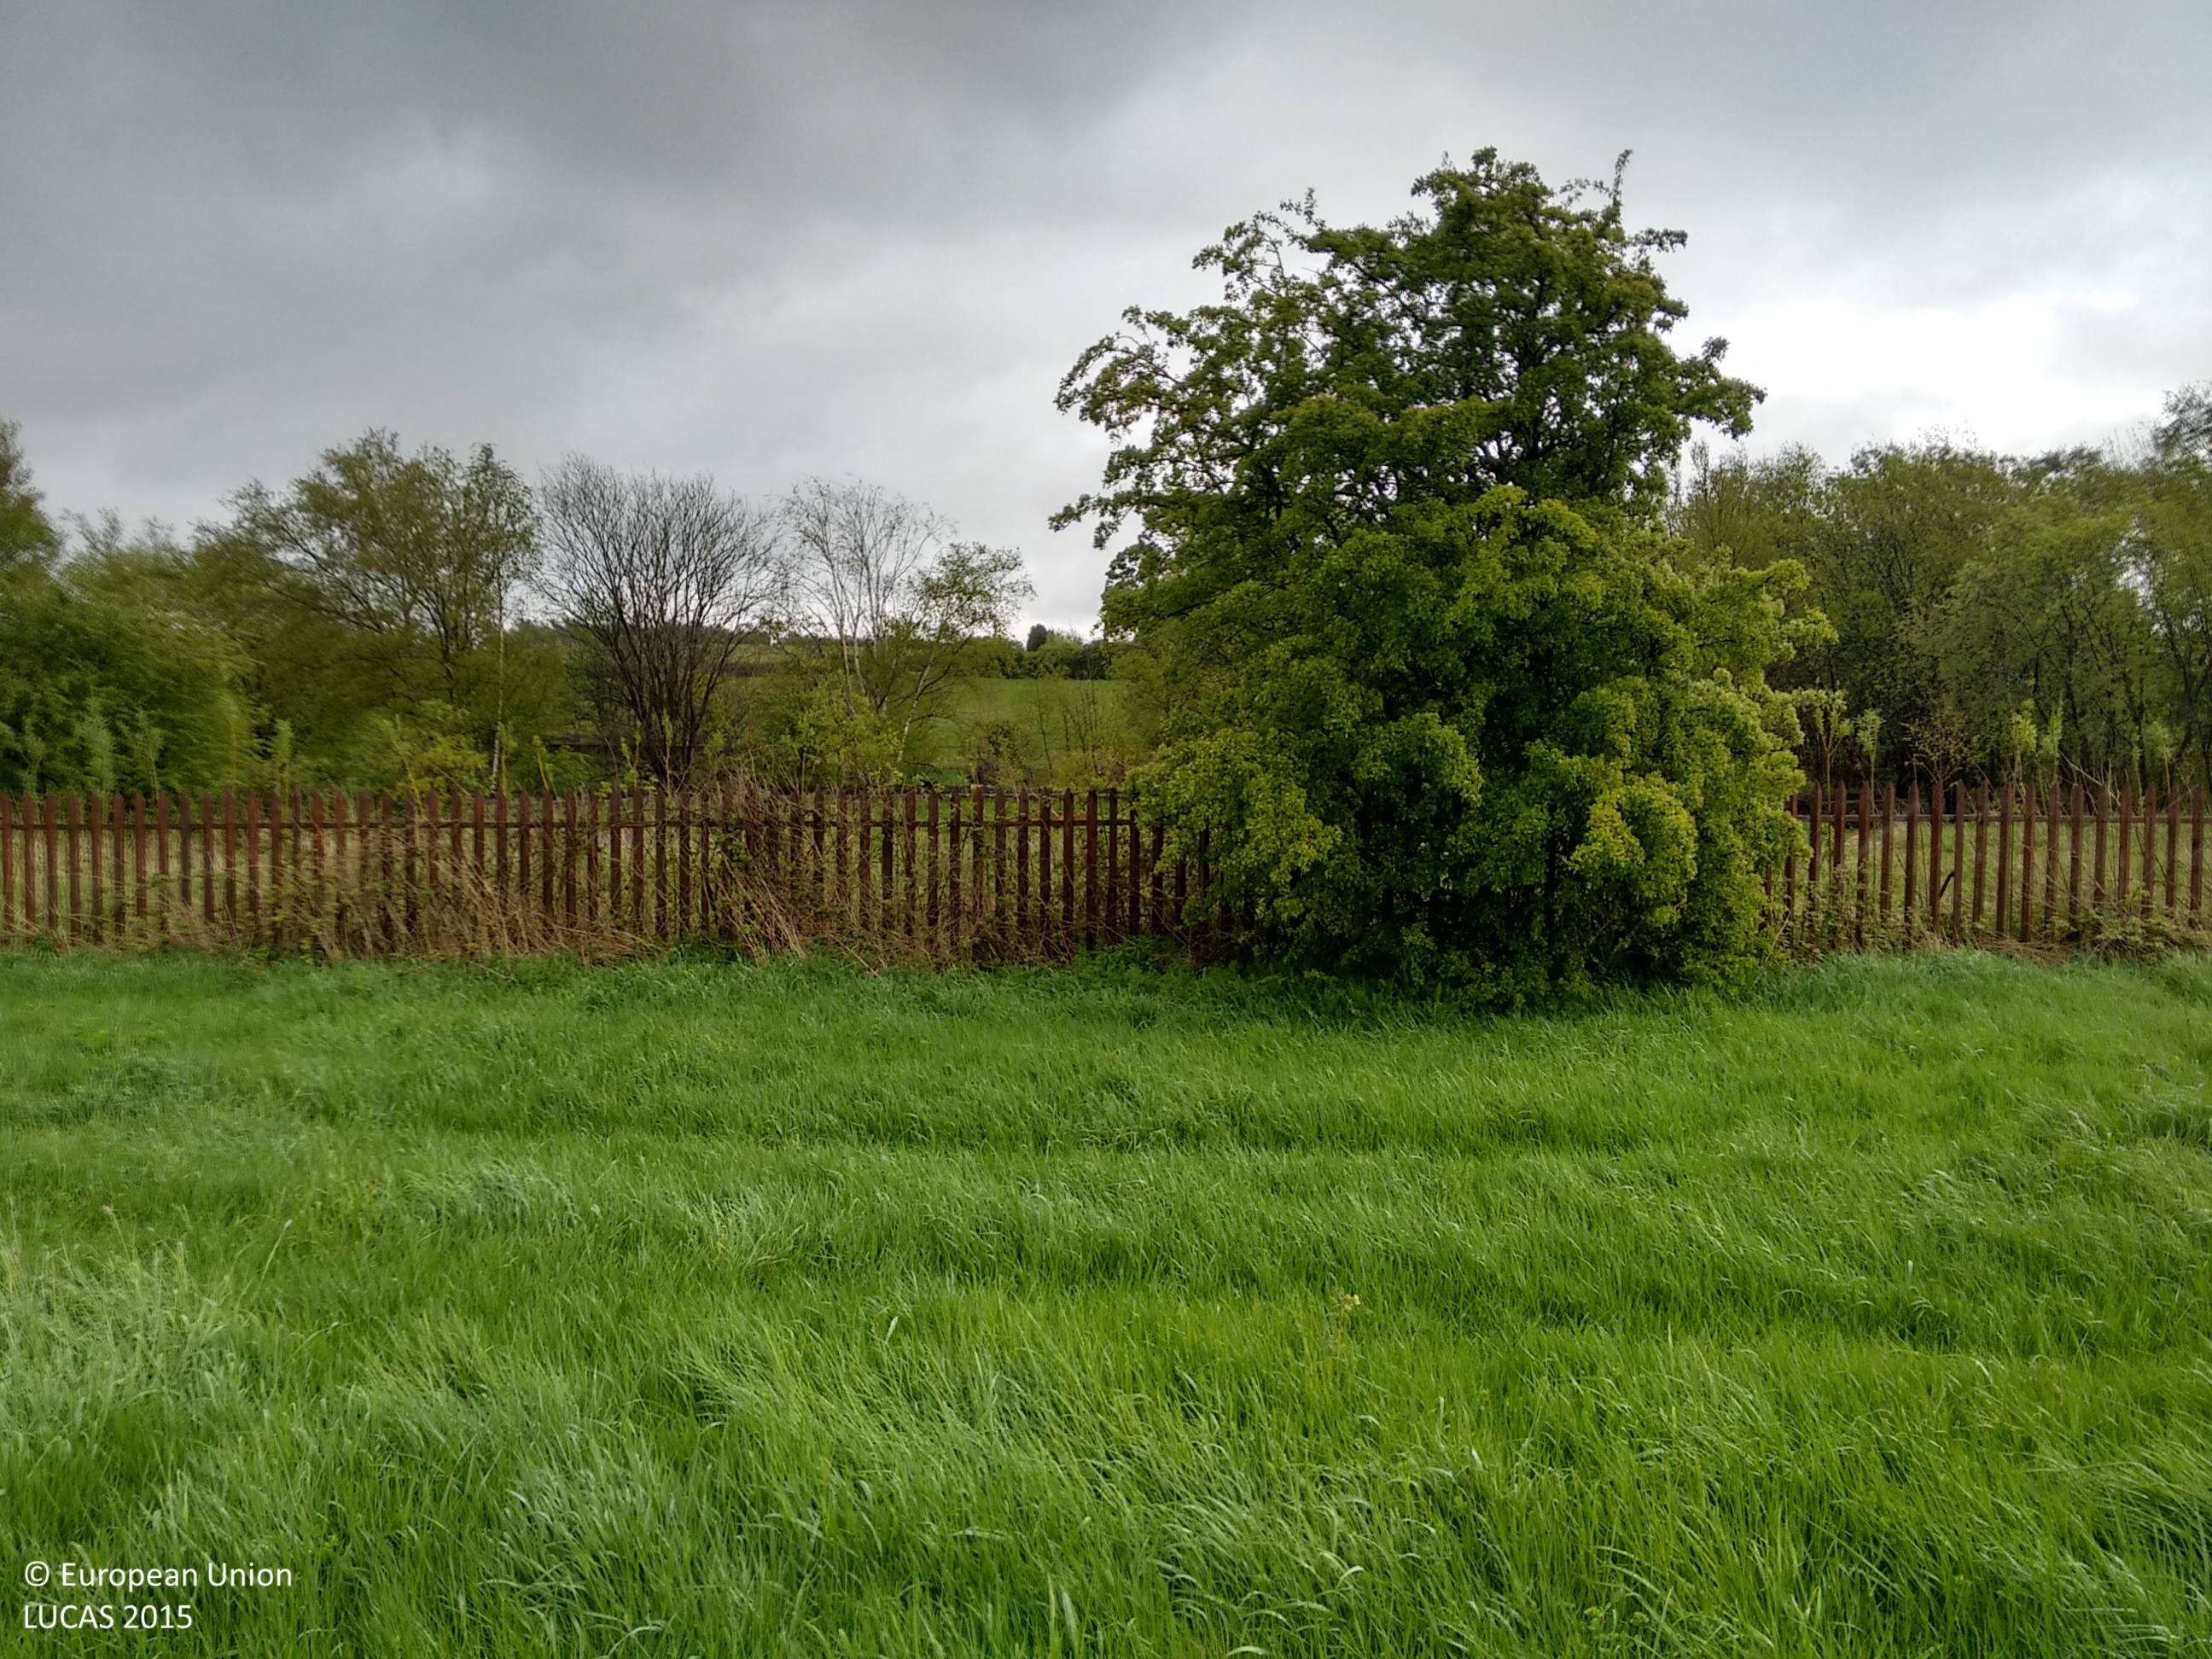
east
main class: Grassland
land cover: Grassland without tree/shrub cover
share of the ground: > 75 %
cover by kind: herbaceous plants 100 %
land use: Agriculture (excluding fallow land and kitchen gardens)
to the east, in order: Grassland without tree/shrub cover; Fences; Spontaneously vegetated surfaces; Artificial constructions in urban areas; Grass margins; Tracks; Grassland without tree/shrub cover; Tracks; Grassland without tree/shrub cover; Tracks; Grassland without tree/shrub cover; Artificial constructions in urban areas; Grass margins; Fences; Grass margins; Rivers and streams; Grassland without tree/shrub cover; Fences; Grassland without tree/shrub cover; Managed hedges; Grass margins; Paved roads, cycling and walking lanes; Grass margins; Managed hedges; Grassland without tree/shrub cover
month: May
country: GB
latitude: 55.8112
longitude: -4.3776
